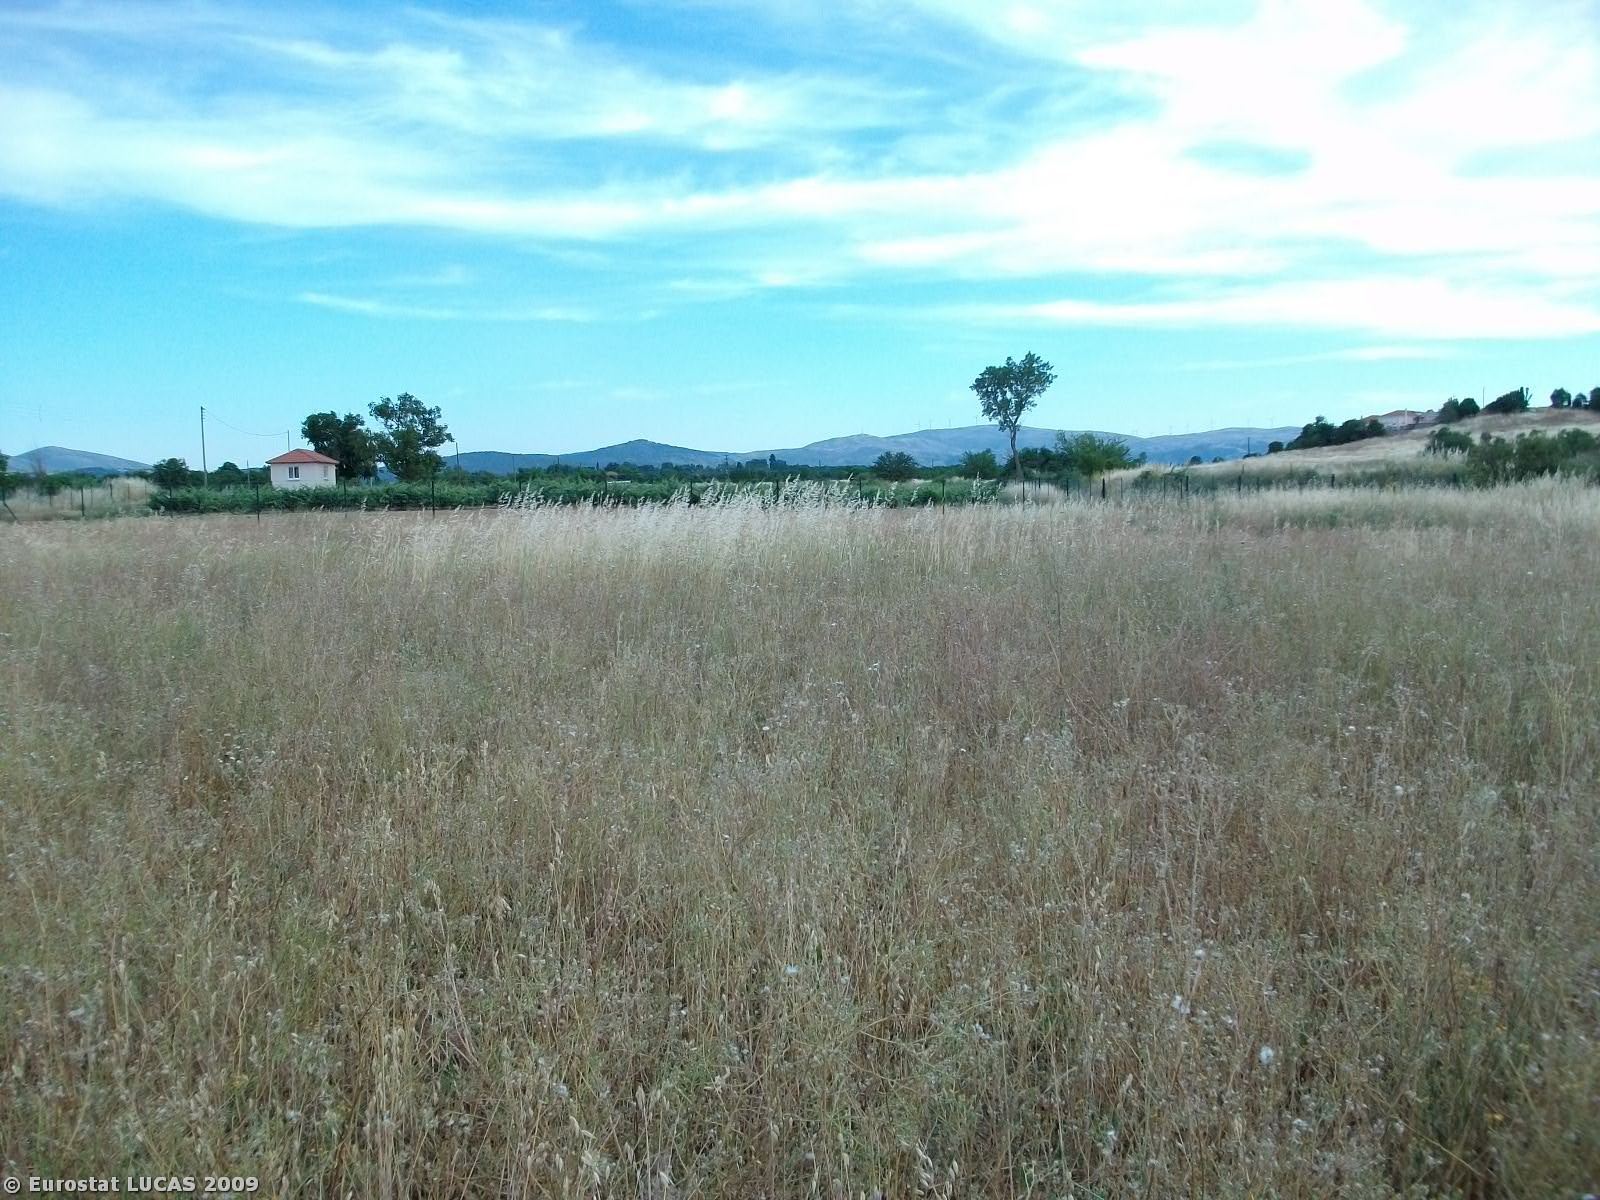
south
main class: Grassland
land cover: Spontaneously vegetated surfaces
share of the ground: > 75 %
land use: Fallow land
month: June
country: GR
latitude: 37.4778
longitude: 22.4347
